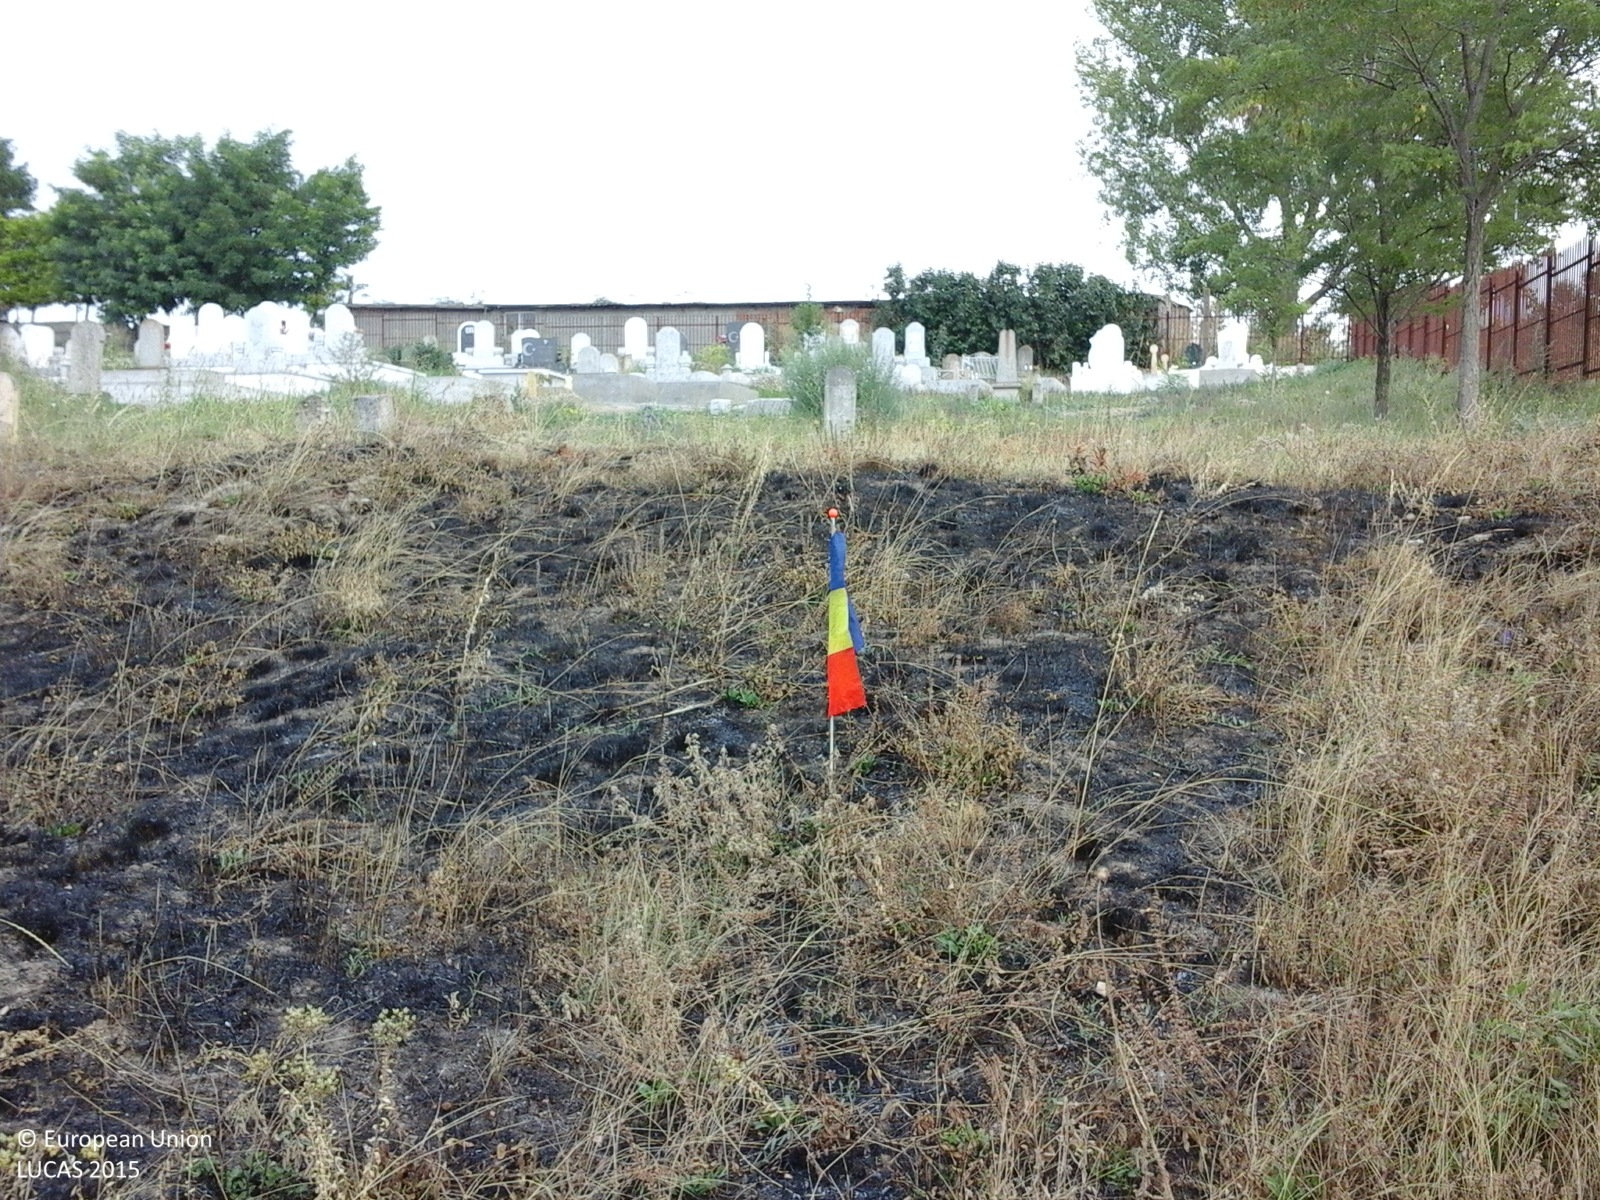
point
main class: Grassland
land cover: Spontaneously vegetated surfaces
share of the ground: > 75 %
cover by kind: herbaceous plants 100 %
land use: Community services
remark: Burnt area
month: July
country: RO
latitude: 45.1626
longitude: 28.8039
